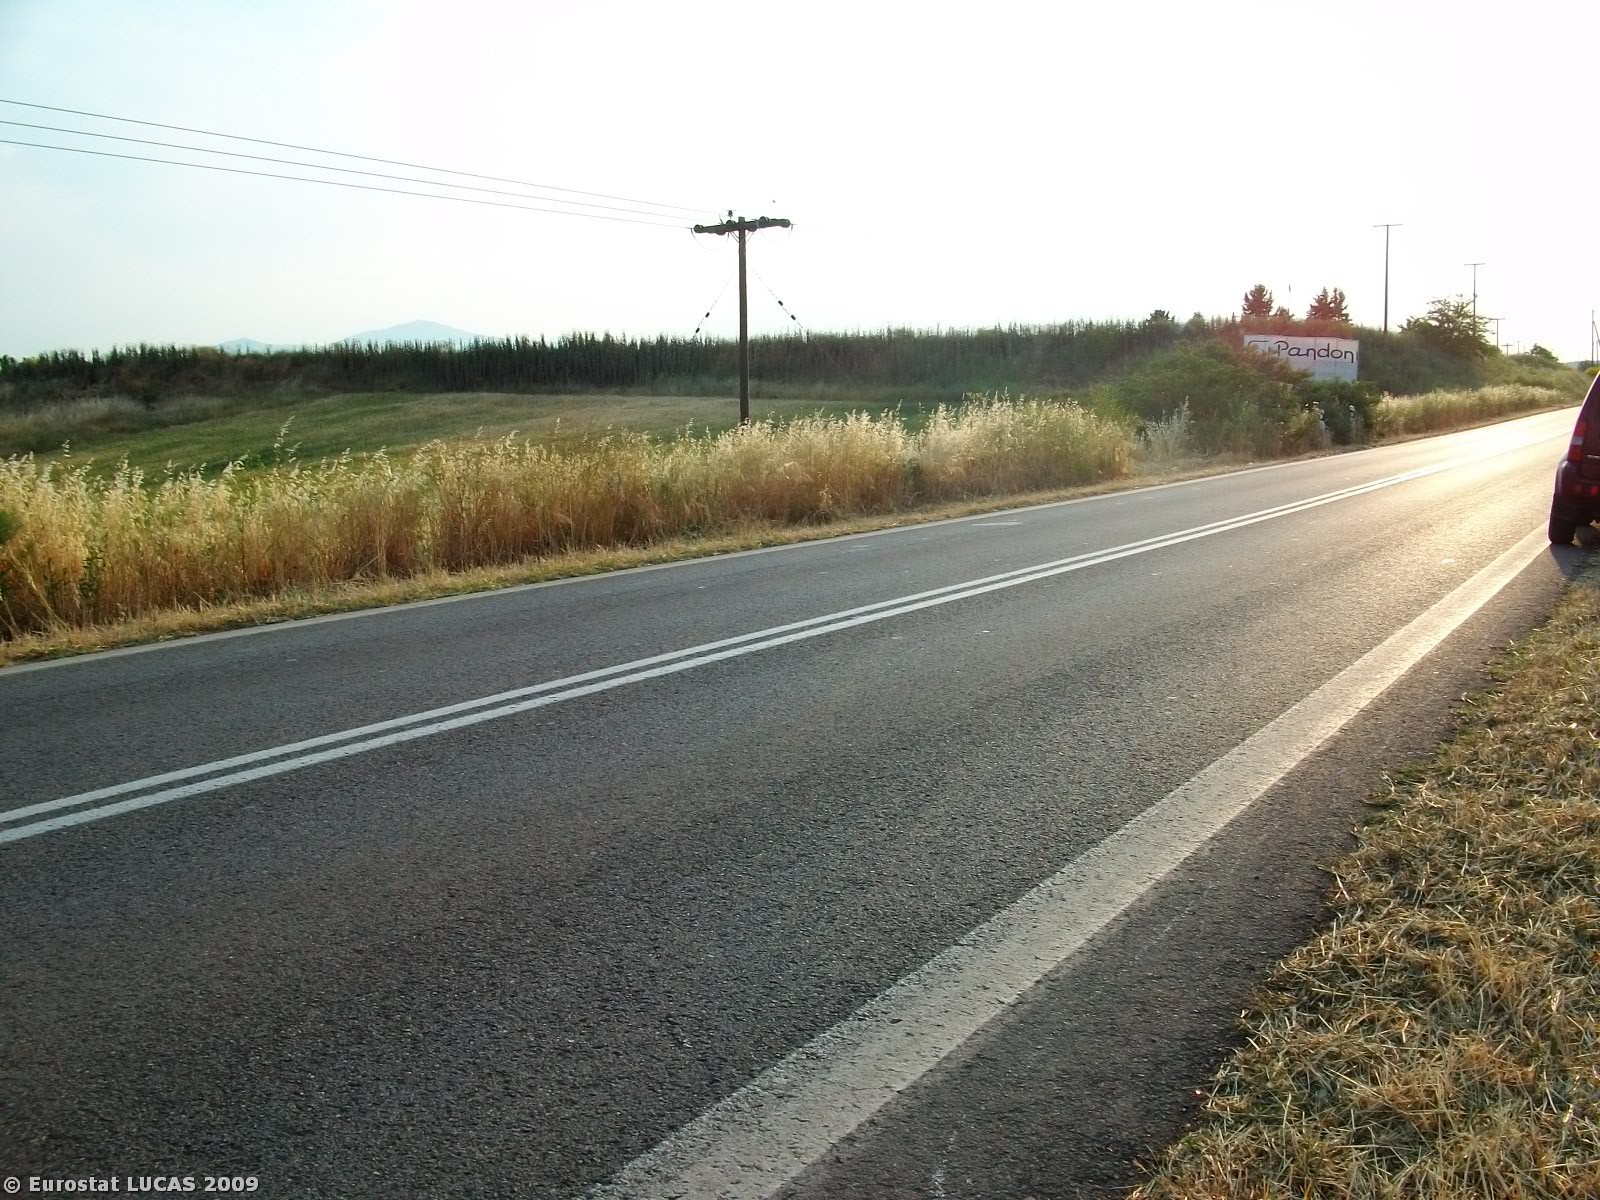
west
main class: Cropland
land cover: Common wheat
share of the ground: > 75 %
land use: Agriculture (excluding fallow land and kitchen gardens)
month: May
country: GR
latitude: 38.9278
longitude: 22.2644
